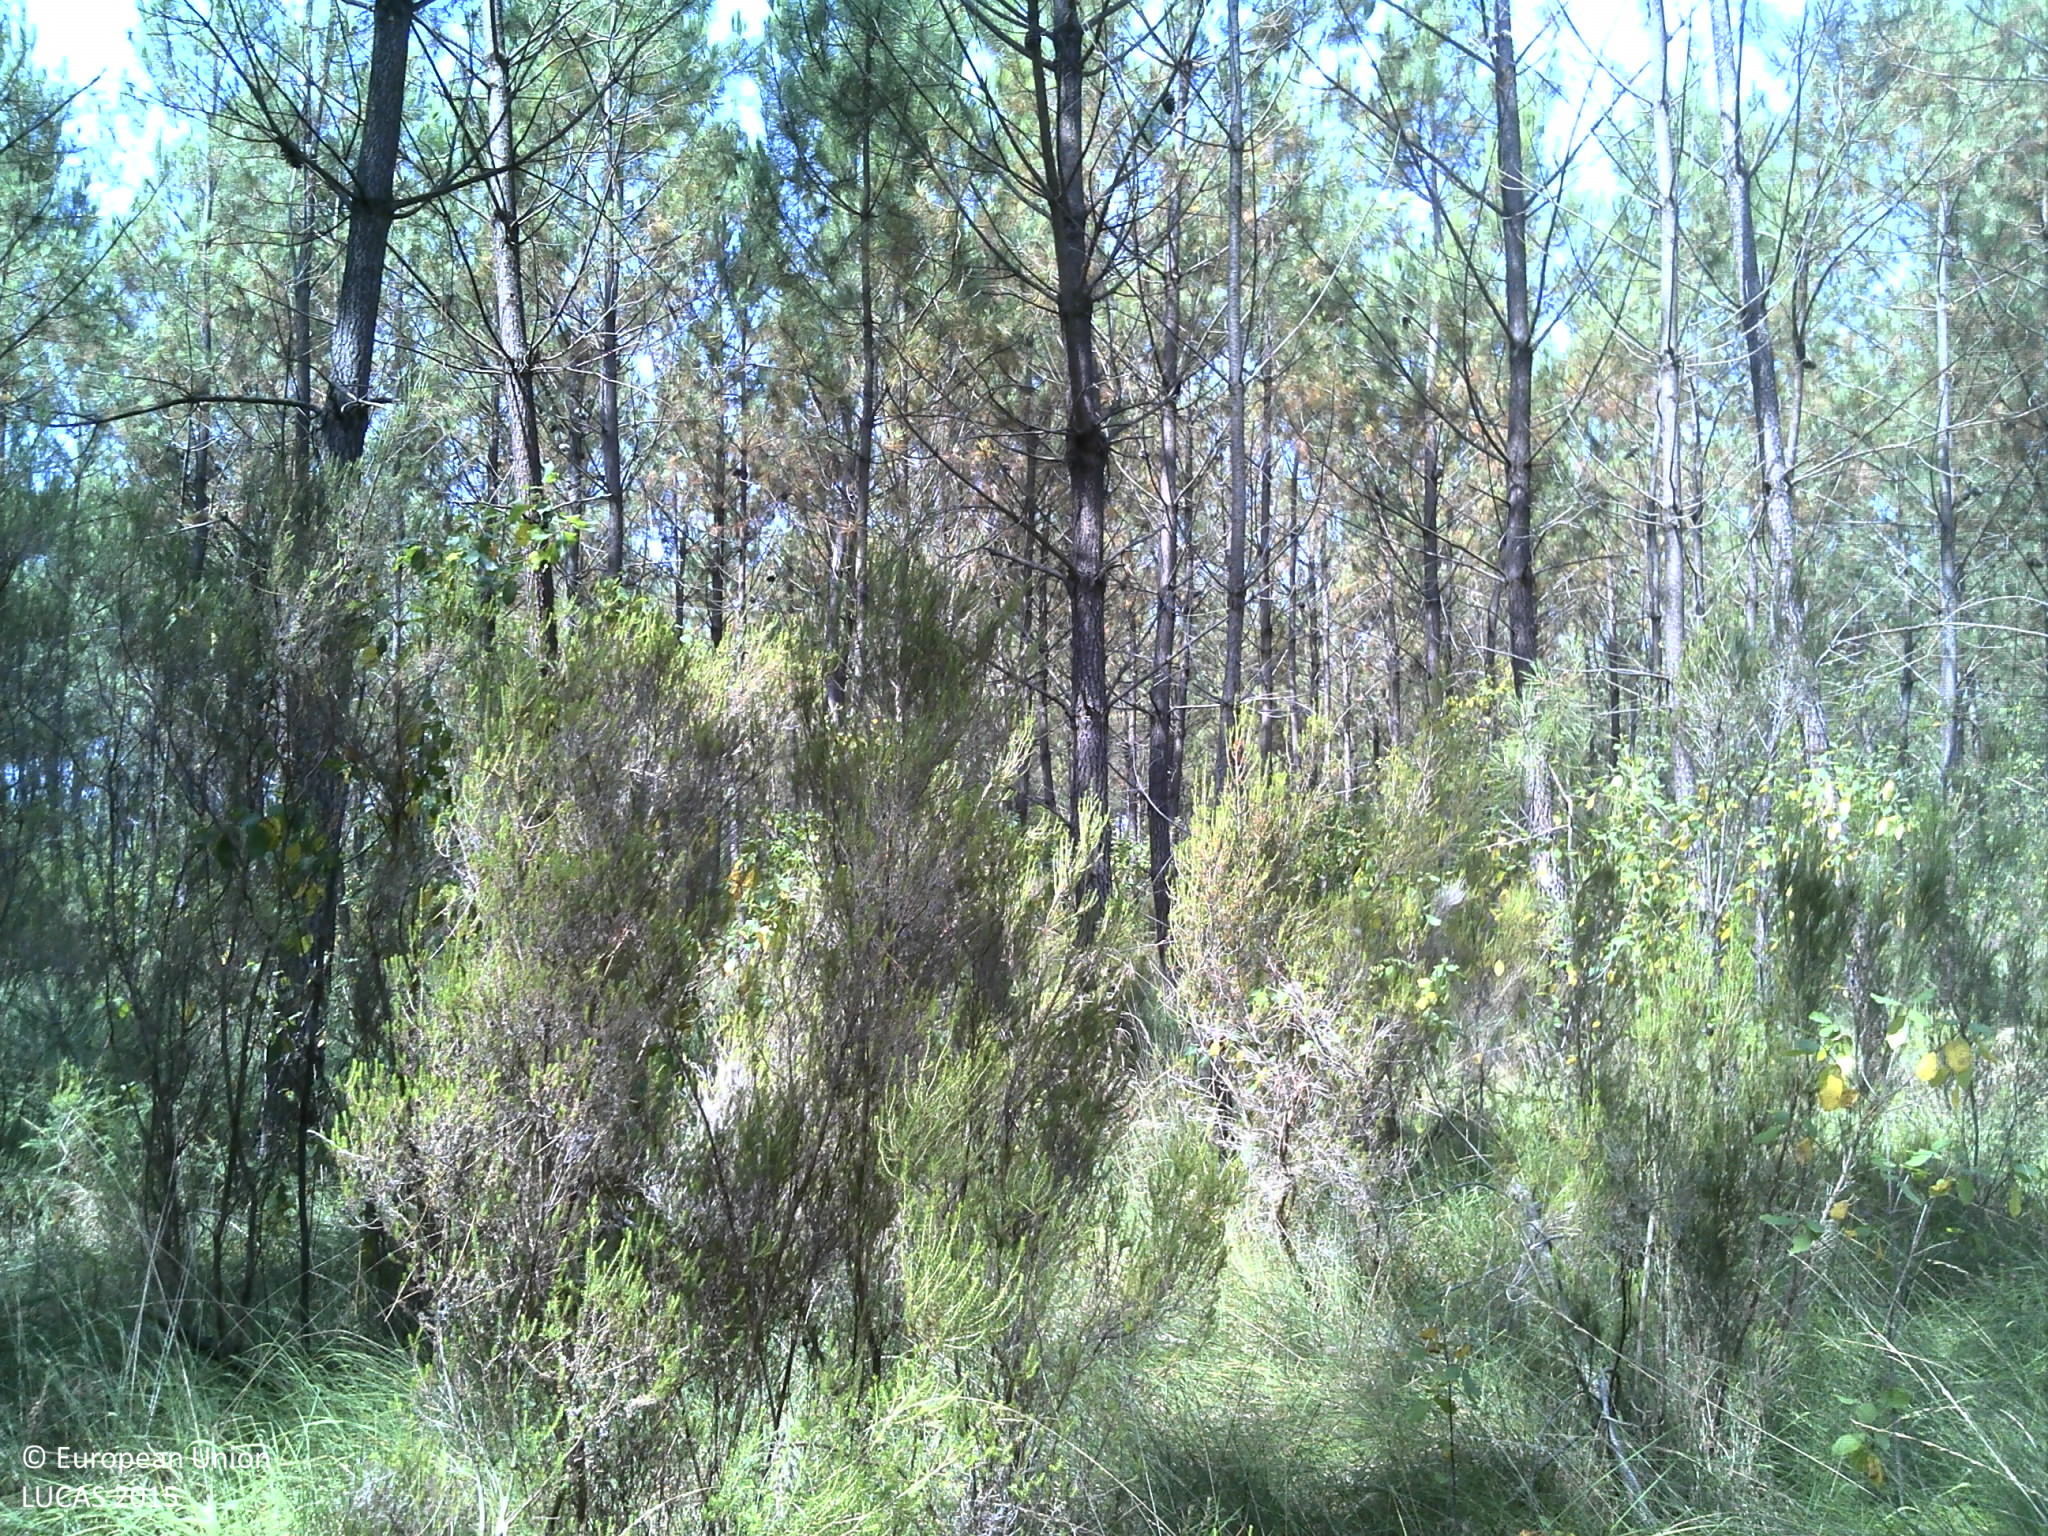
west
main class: Woodland
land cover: Pine dominated coniferous woodland
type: coniferous forest of the mediterranean region
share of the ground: > 75 %
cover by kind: coniferous forest trees 70 %, shrubs 20 %, herbaceous plants 10 %
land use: Forestry
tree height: > 5 m
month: July
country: FR
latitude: 44.5942
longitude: -0.7134
